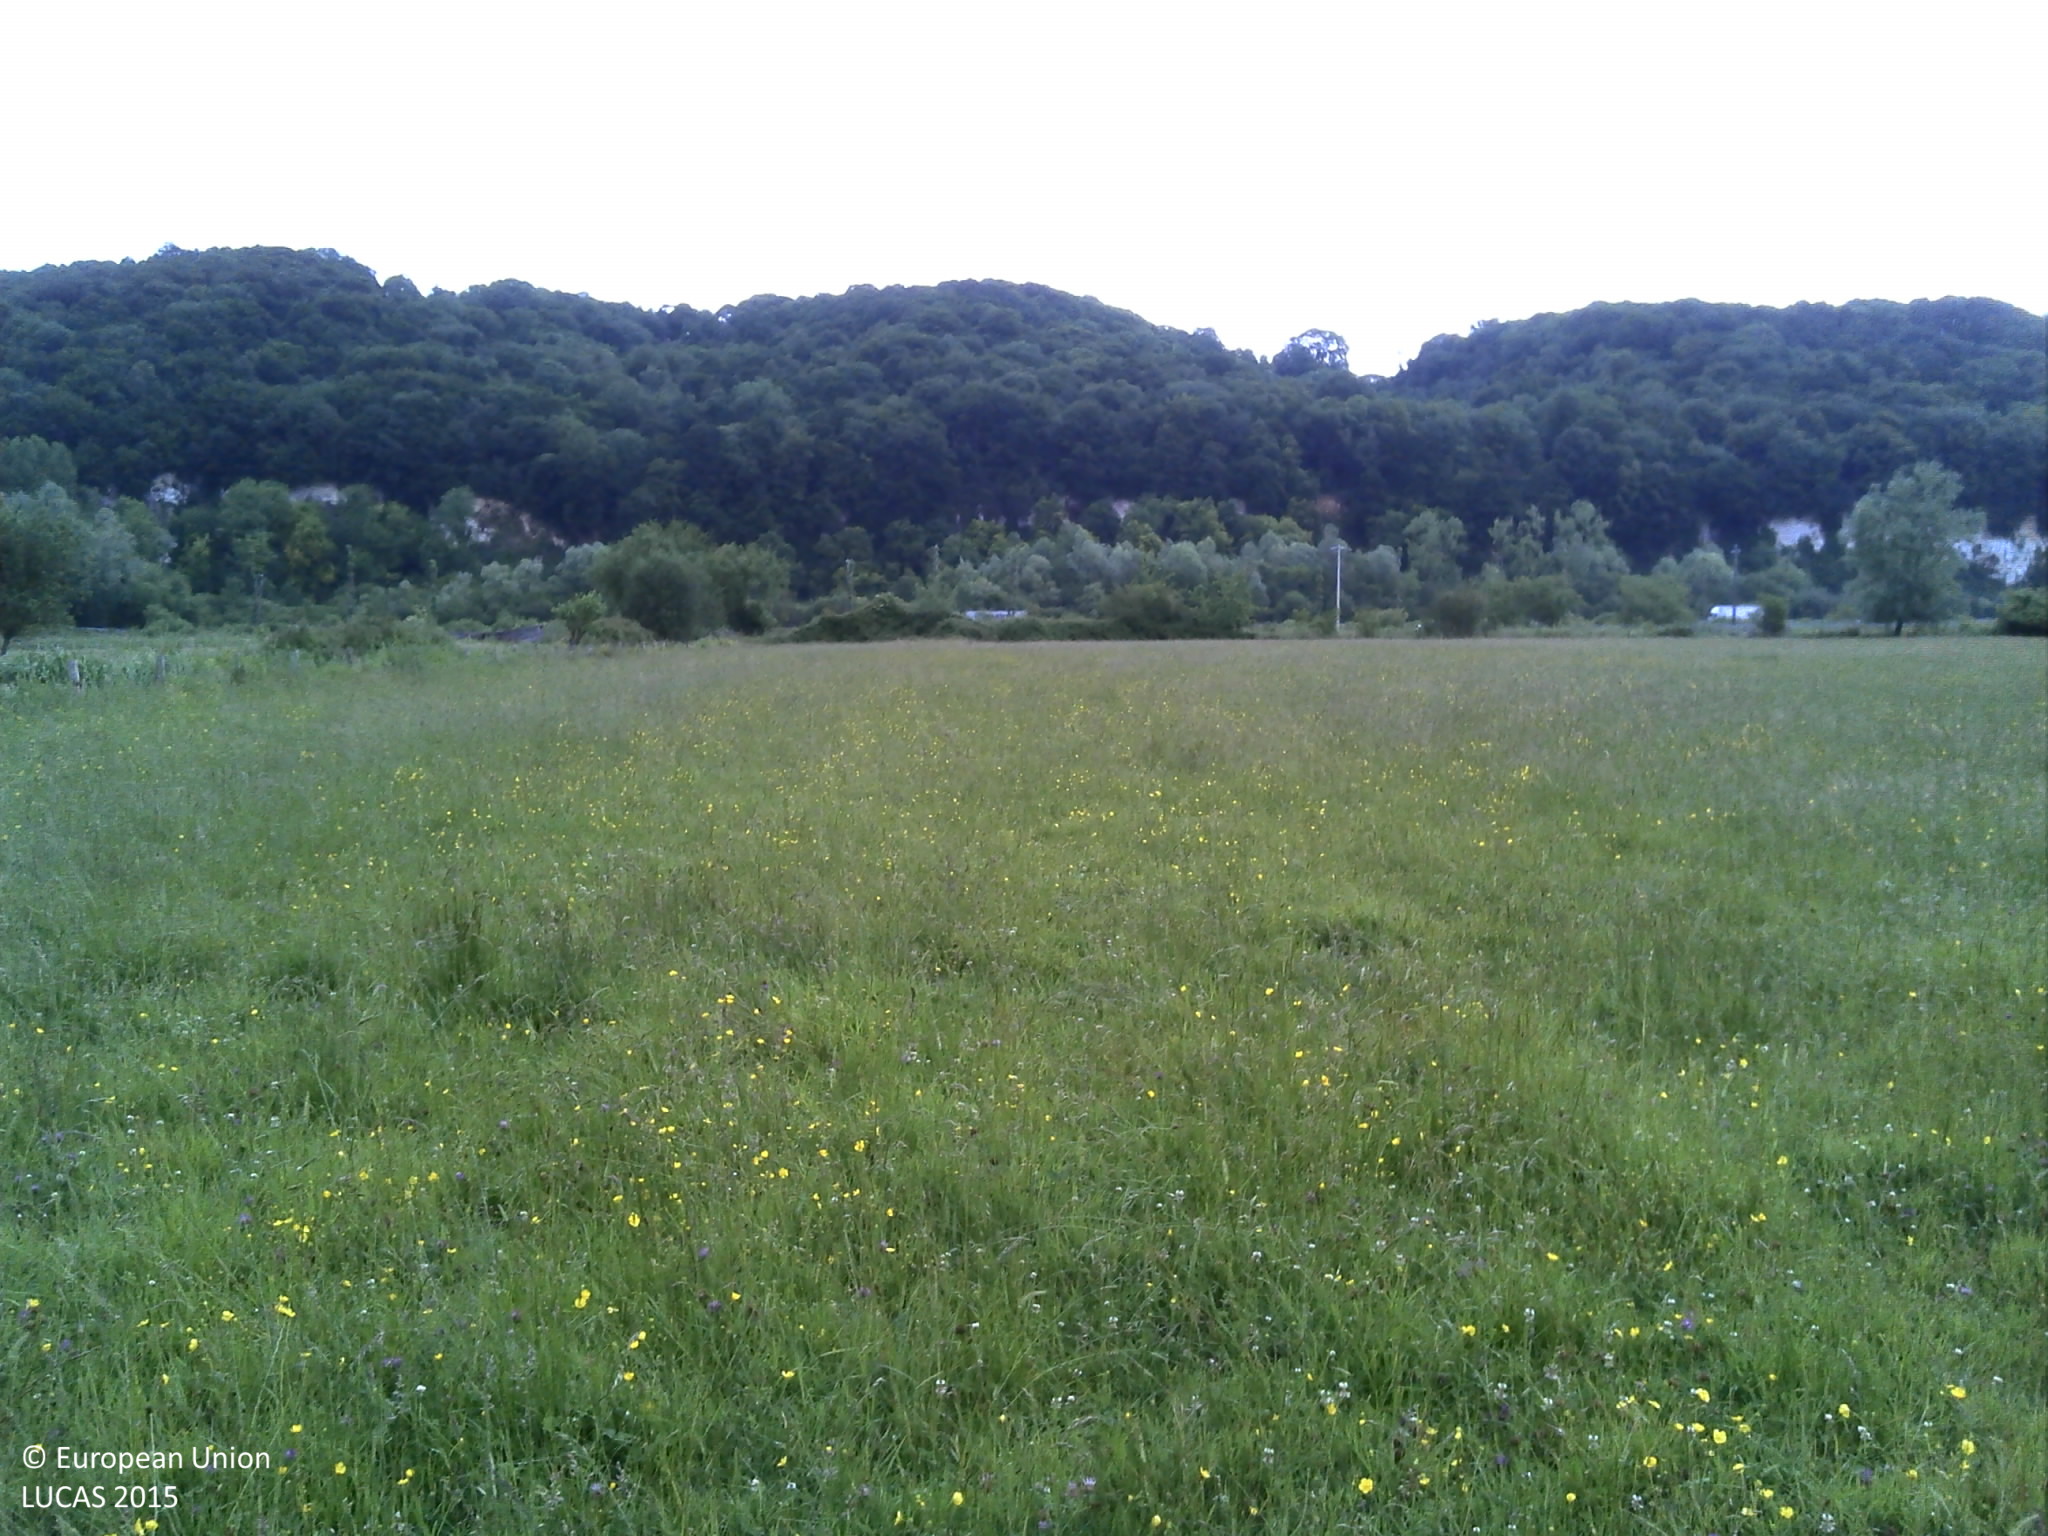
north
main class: Grassland
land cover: Grassland without tree/shrub cover
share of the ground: > 75 %
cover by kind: herbaceous plants 100 %
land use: Agriculture (excluding fallow land and kitchen gardens)
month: June
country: FR
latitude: 49.4890
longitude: 0.4057
